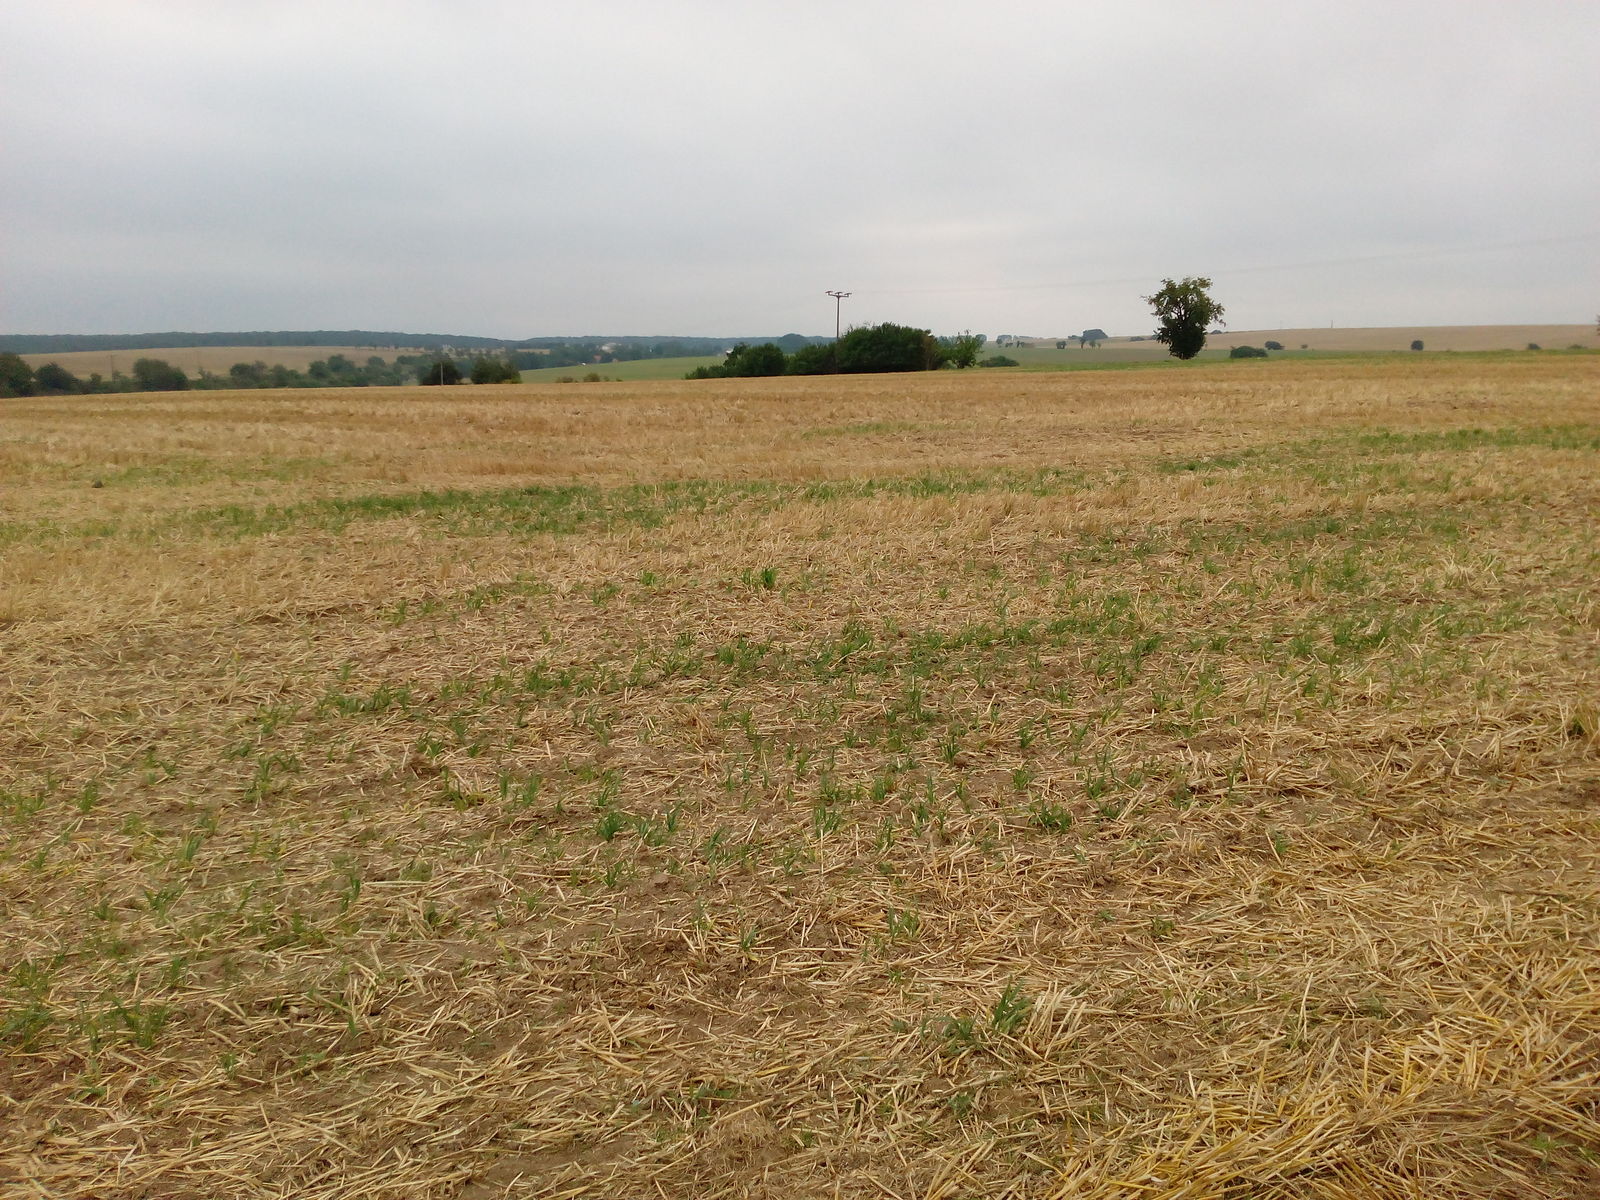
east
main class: Cropland
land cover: Barley
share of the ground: 10 - 25 %
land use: Agriculture (excluding fallow land and kitchen gardens)
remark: Harvested field
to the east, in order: Tracks; Barley
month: August
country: DE
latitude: 51.2254
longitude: 10.6156
